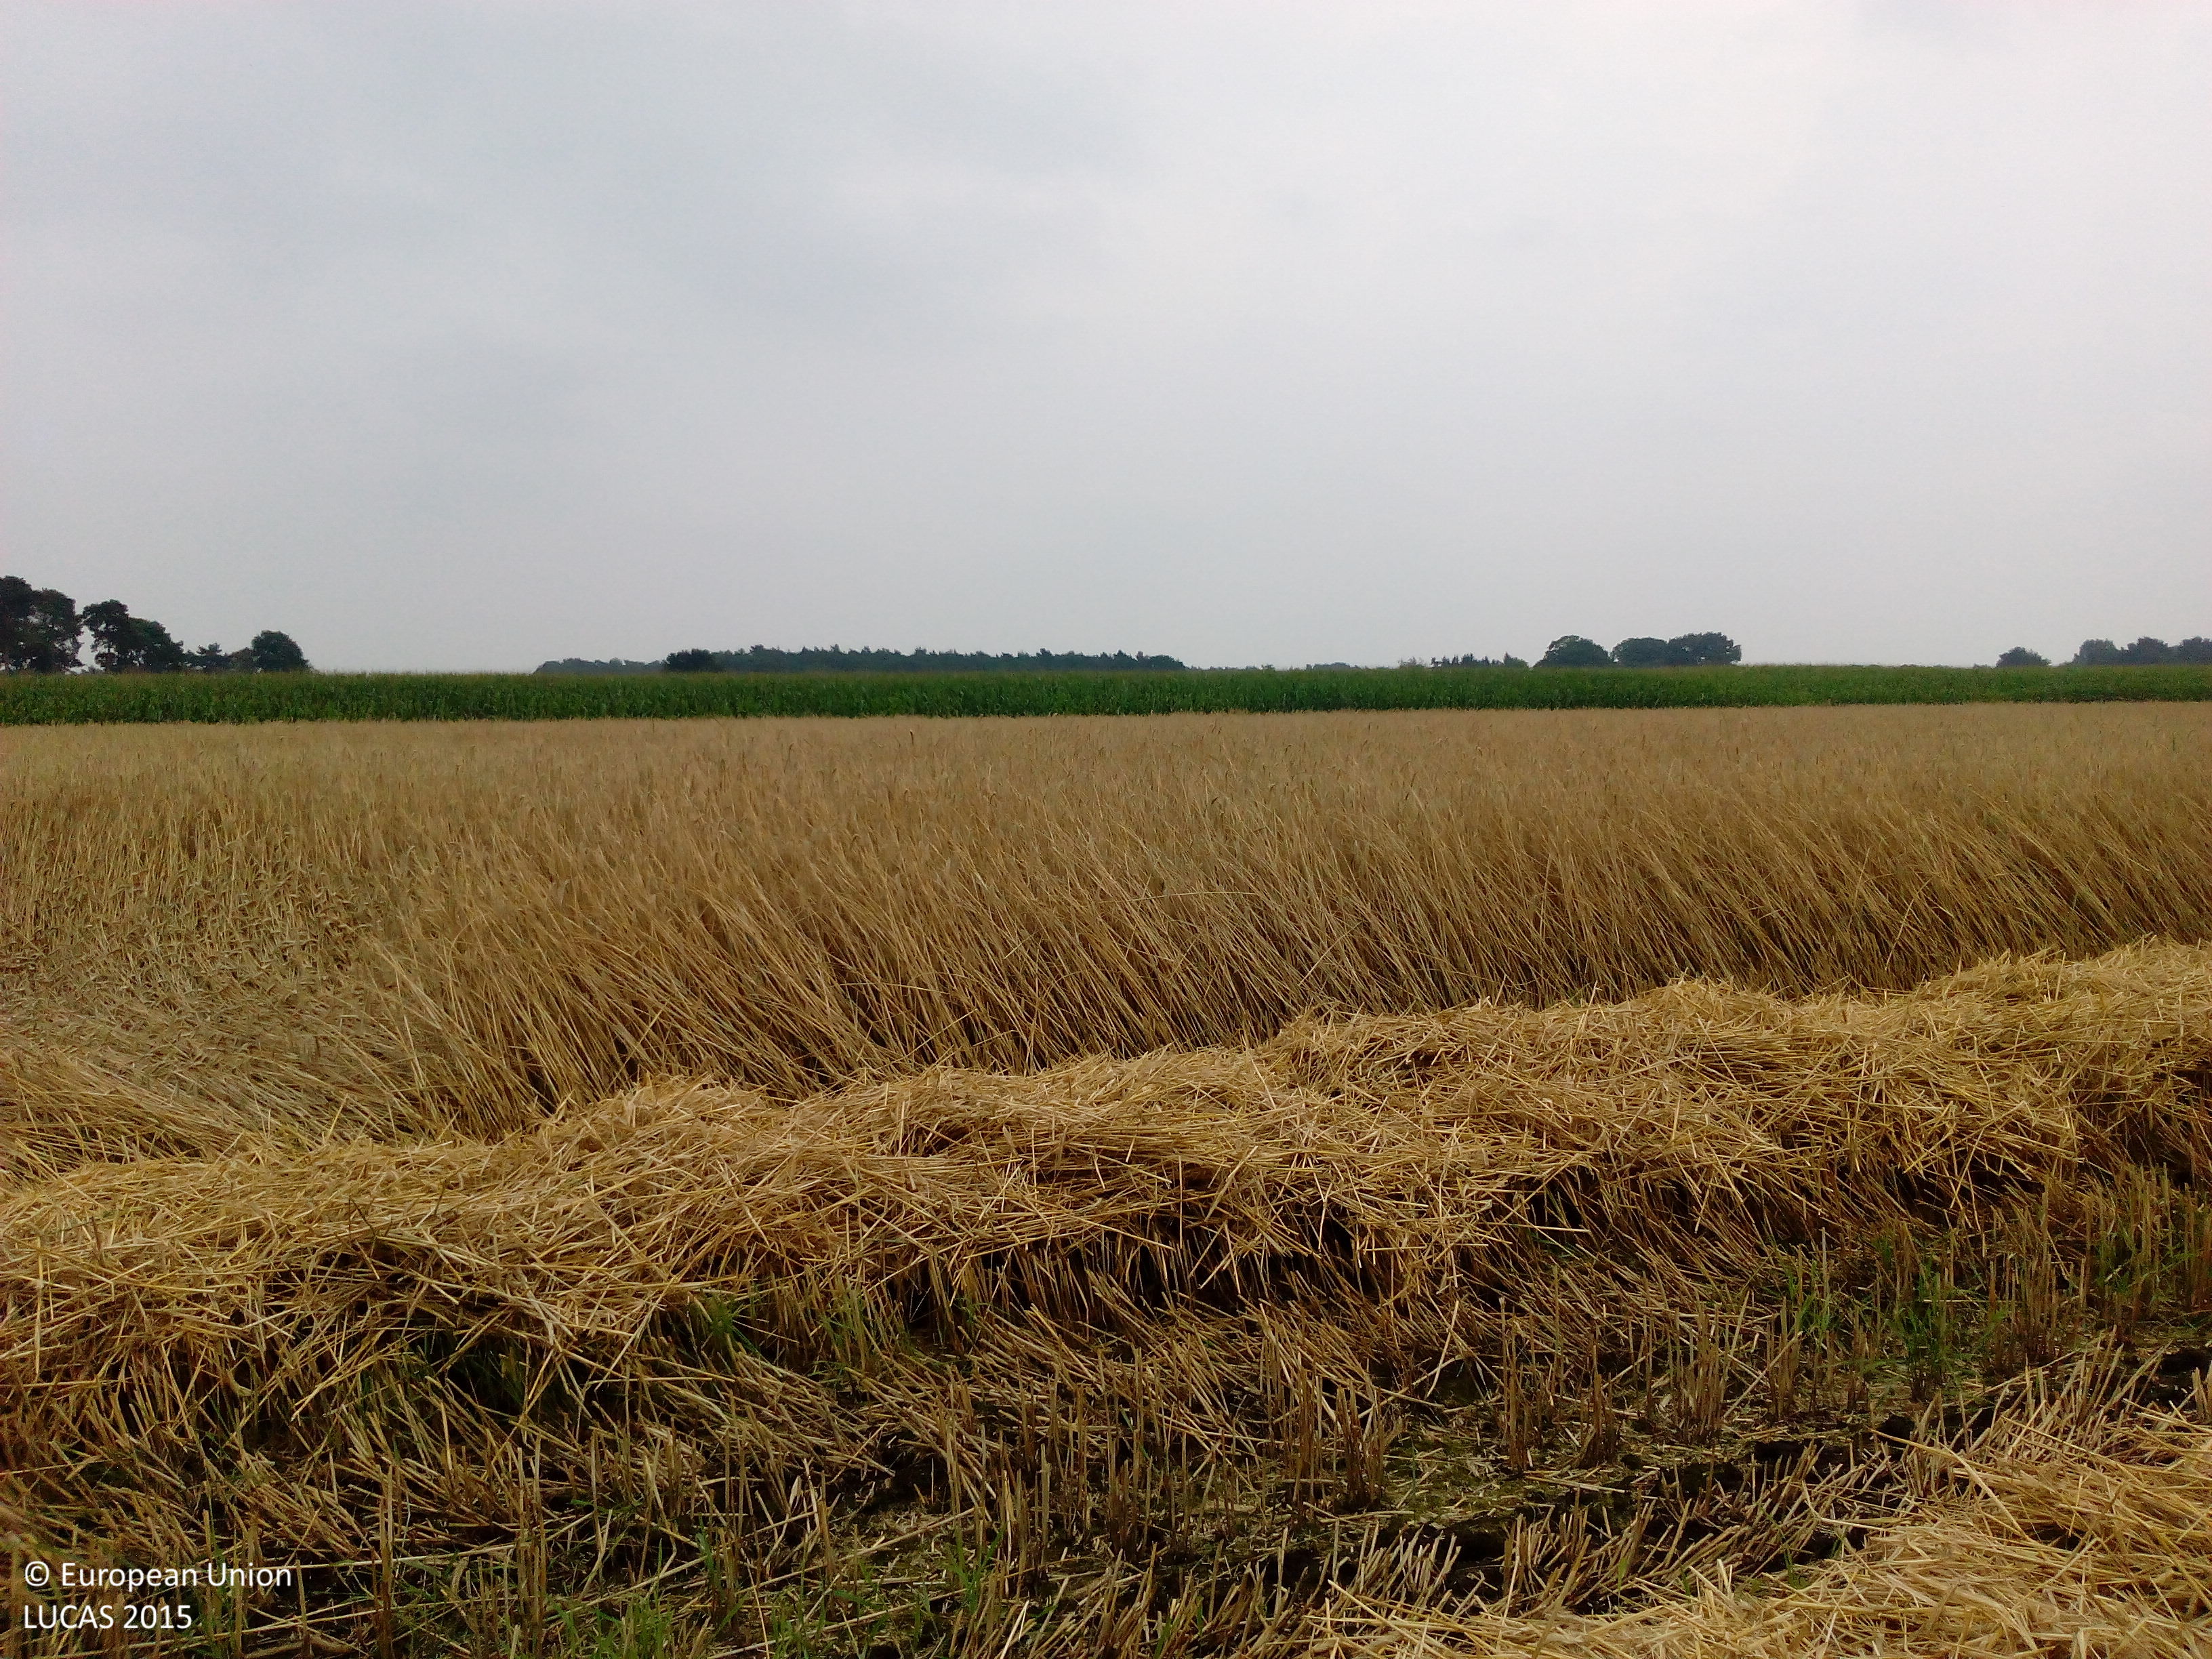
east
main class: Cropland
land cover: Rye
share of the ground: > 75 %
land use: Agriculture (excluding fallow land and kitchen gardens)
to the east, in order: Rye; Maize
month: August
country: DE
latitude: 52.6553
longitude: 8.4778
